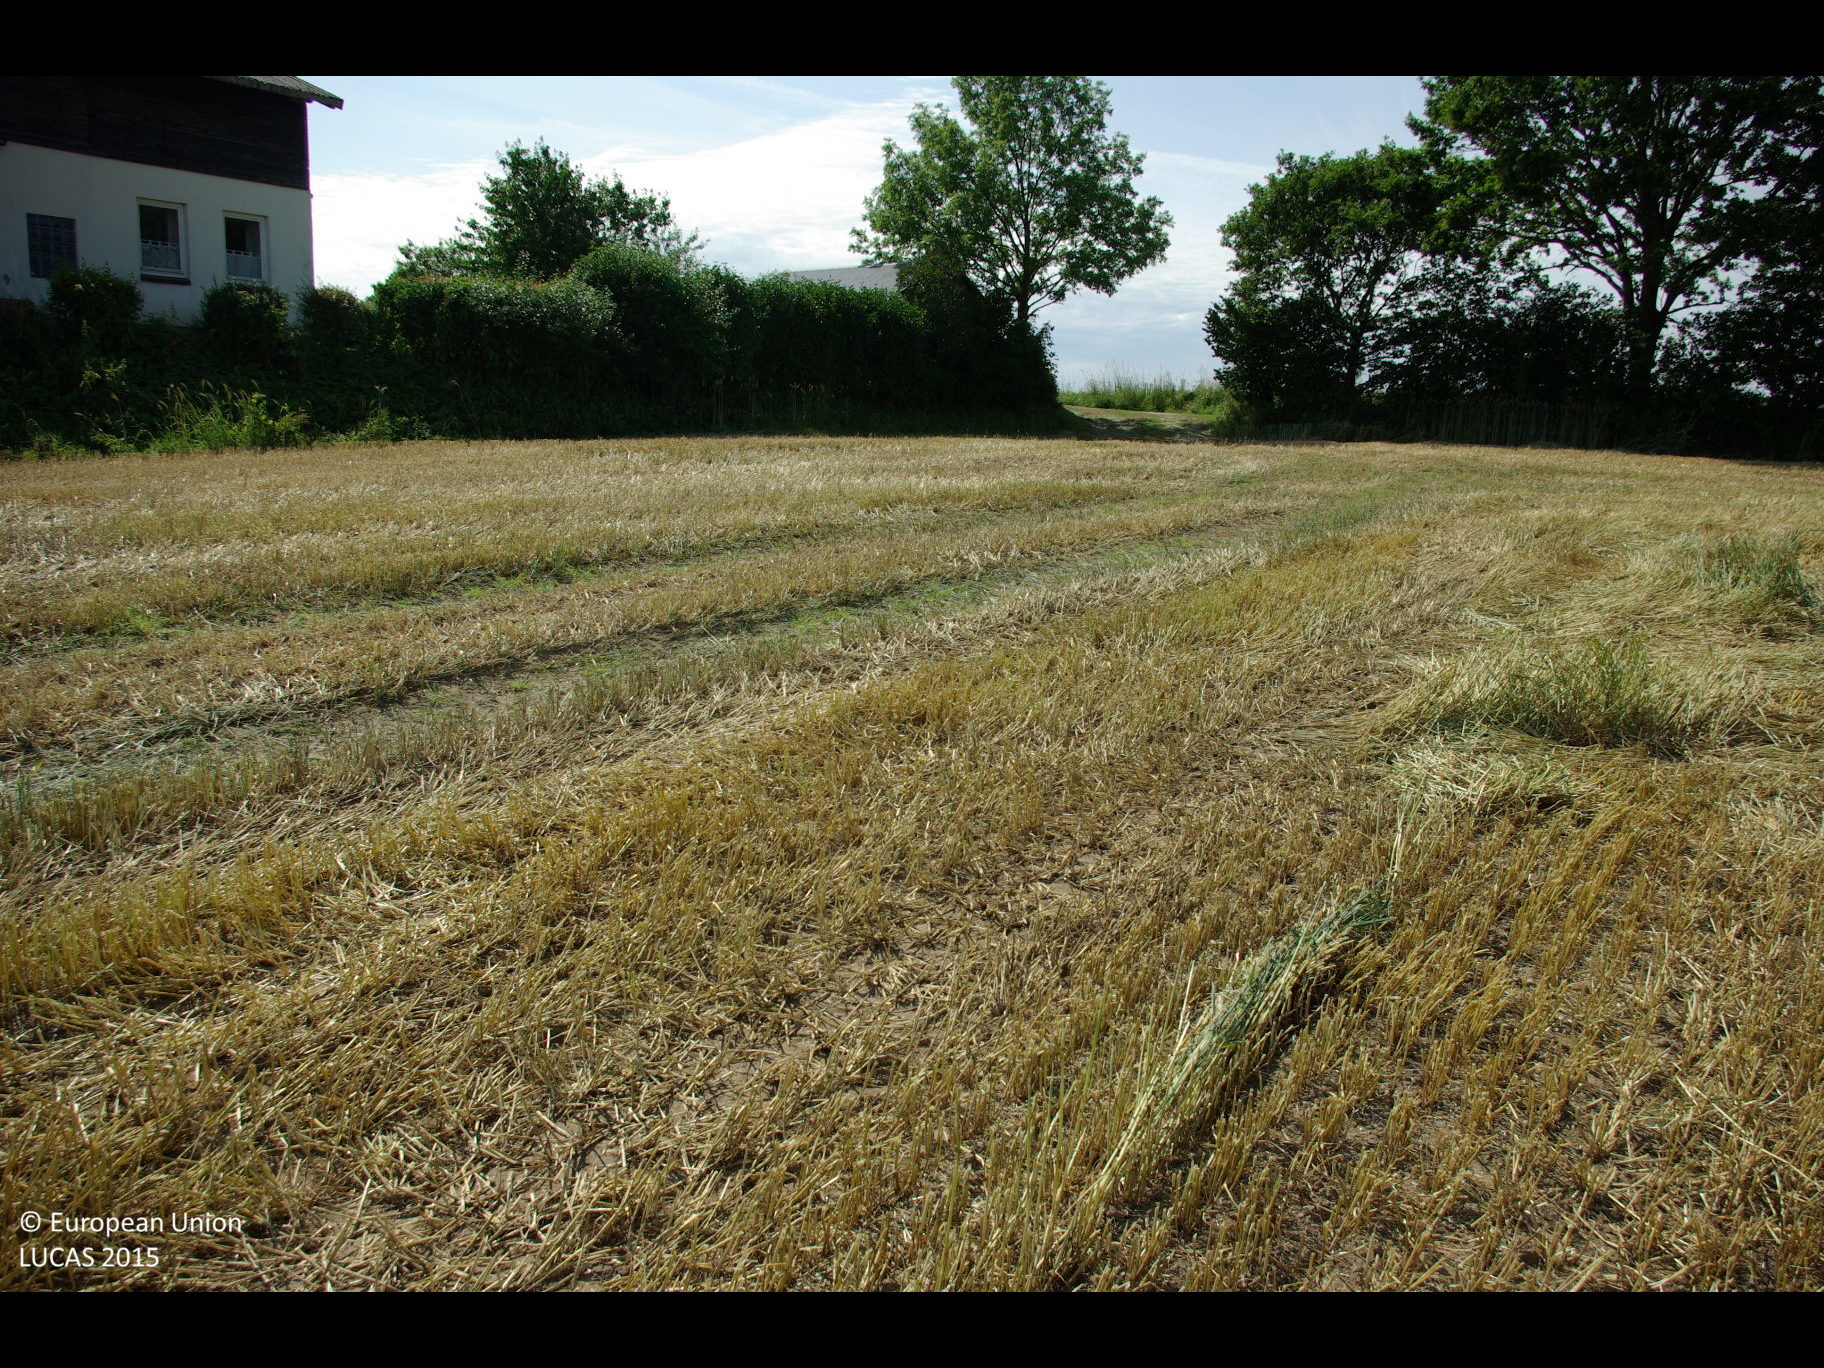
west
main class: Cropland
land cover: Rye
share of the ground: 10 - 25 %
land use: Agriculture (excluding fallow land and kitchen gardens)
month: July
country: DE
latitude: 54.6232
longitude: 9.5512
